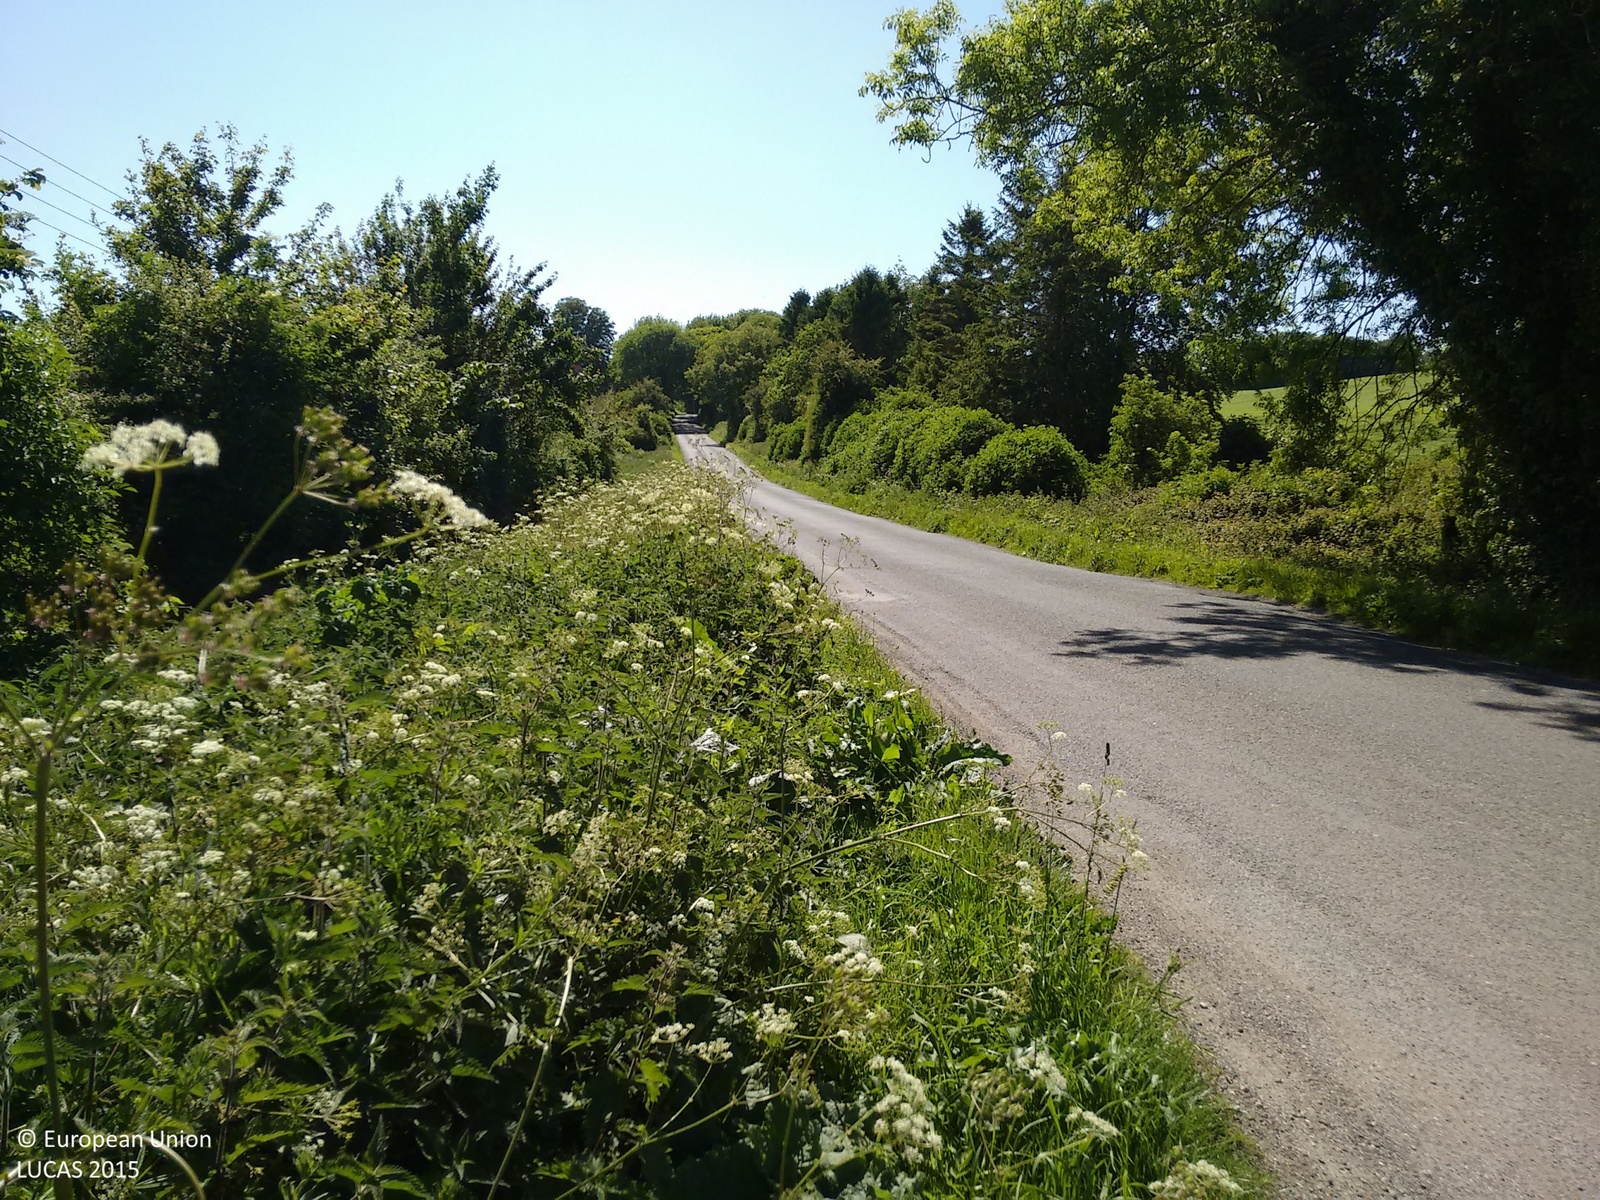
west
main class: Grassland
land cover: Spontaneously vegetated surfaces
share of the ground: > 75 %
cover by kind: herbaceous plants 95 %, shrubs 5 %
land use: Abandoned areas
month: June
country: GB
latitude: 50.7231
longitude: -2.4025
